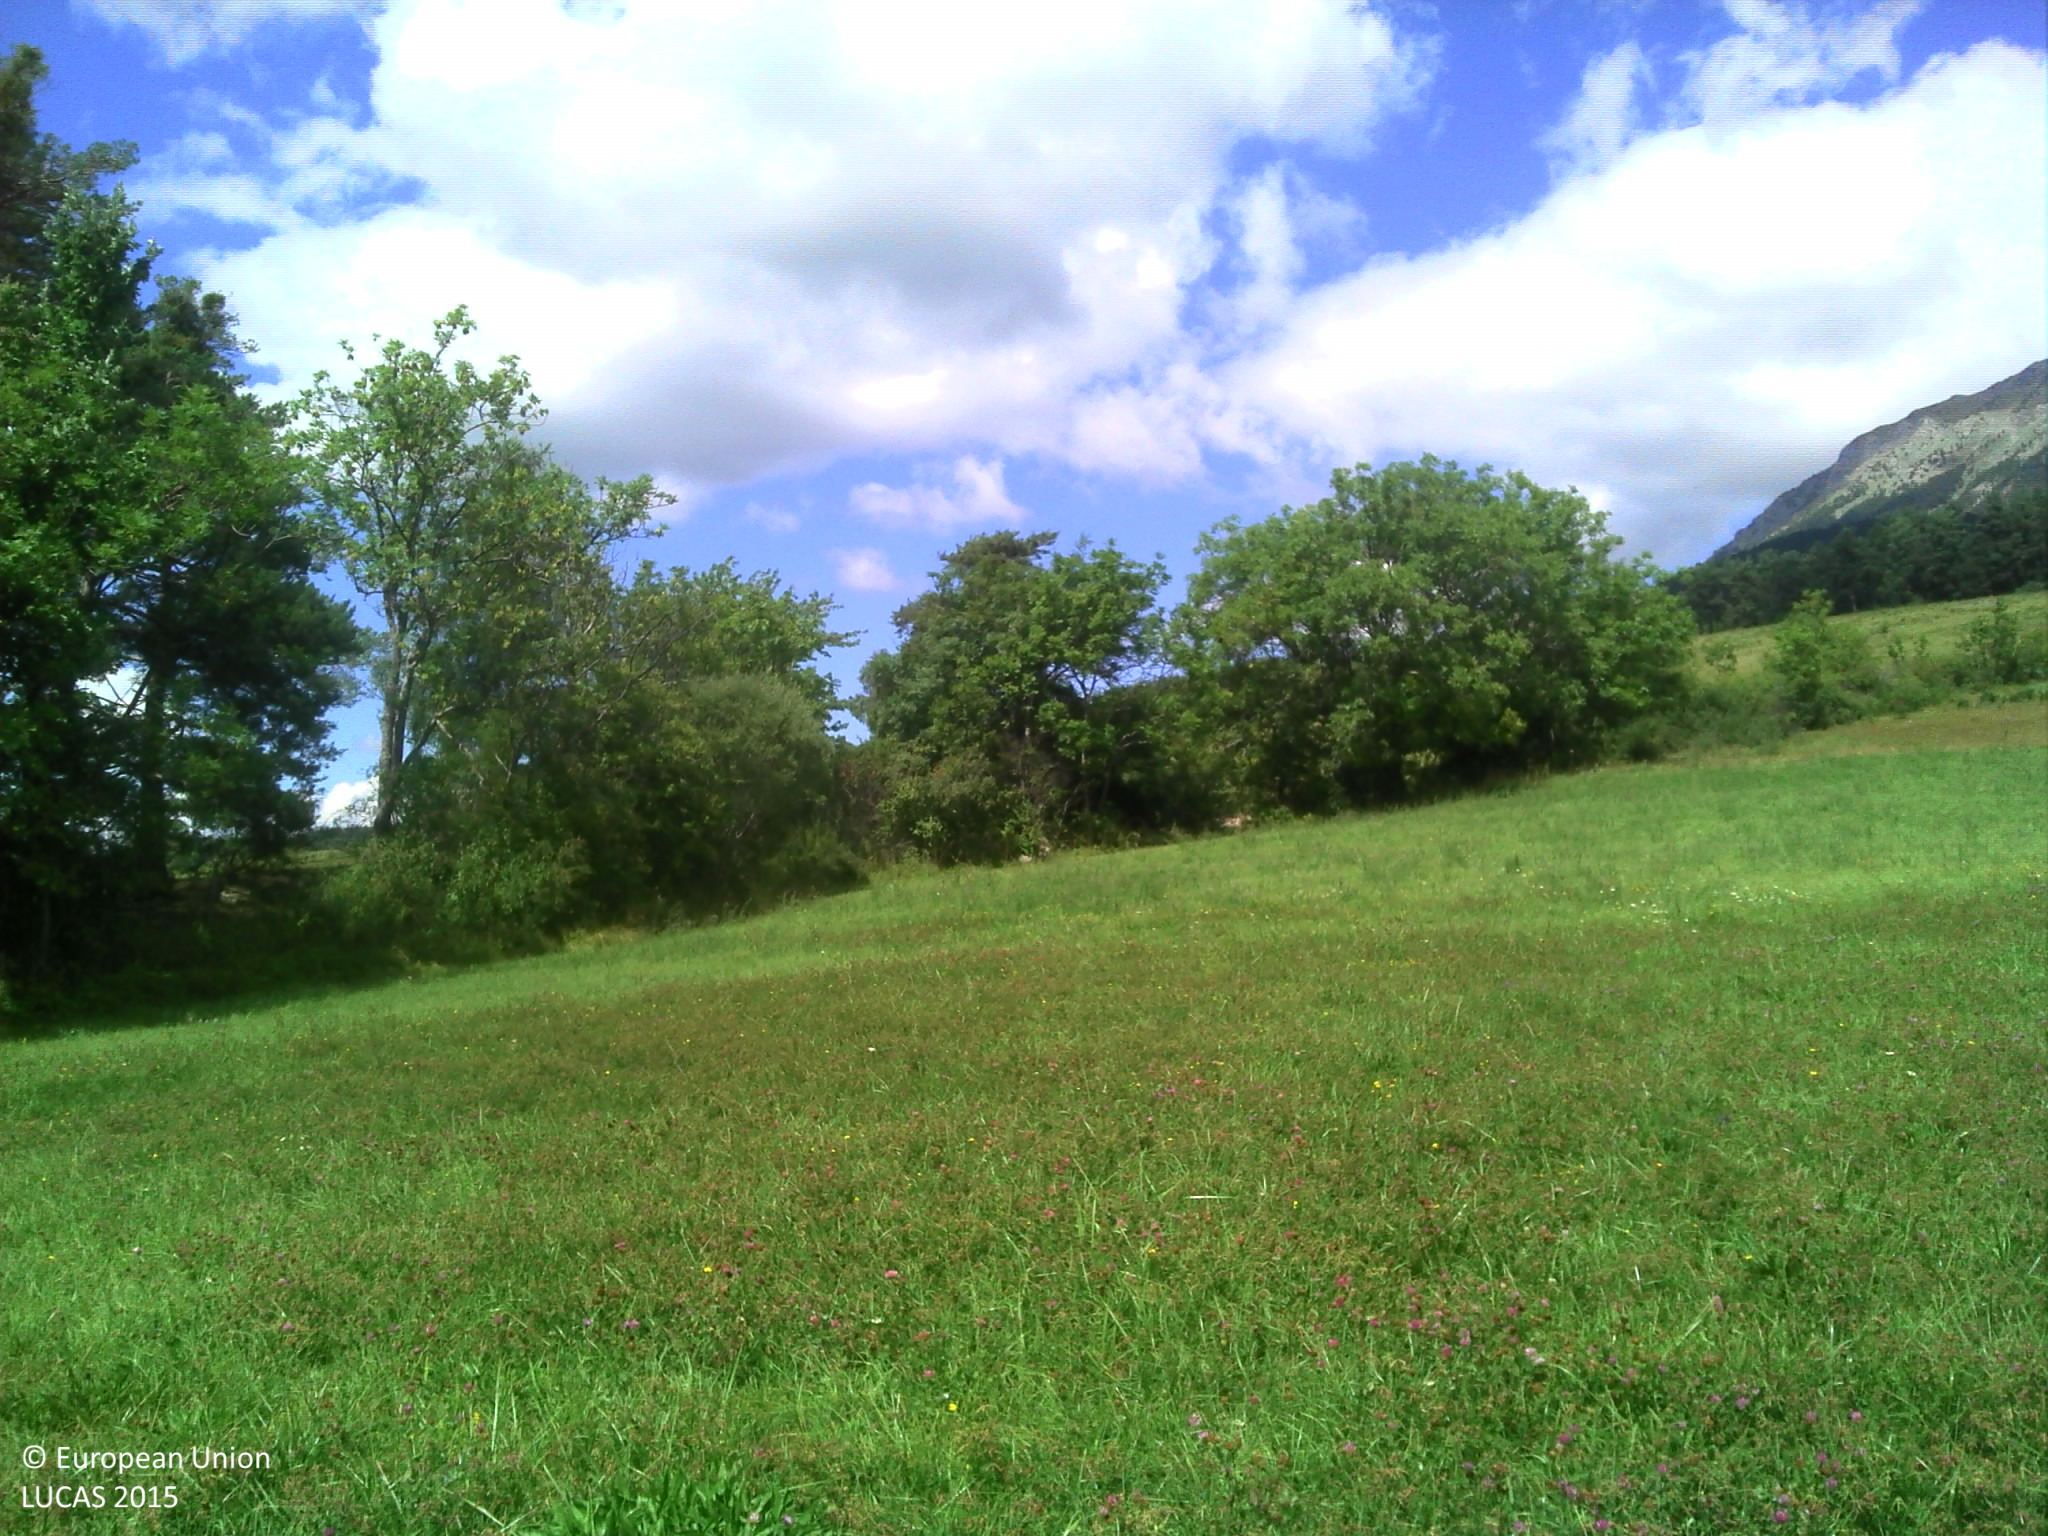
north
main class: Grassland
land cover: Grassland without tree/shrub cover
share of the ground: > 75 %
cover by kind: herbaceous plants 100 %
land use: Agriculture (excluding fallow land and kitchen gardens)
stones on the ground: < 10 %
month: August
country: FR
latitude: 44.3768
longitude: 6.3546
